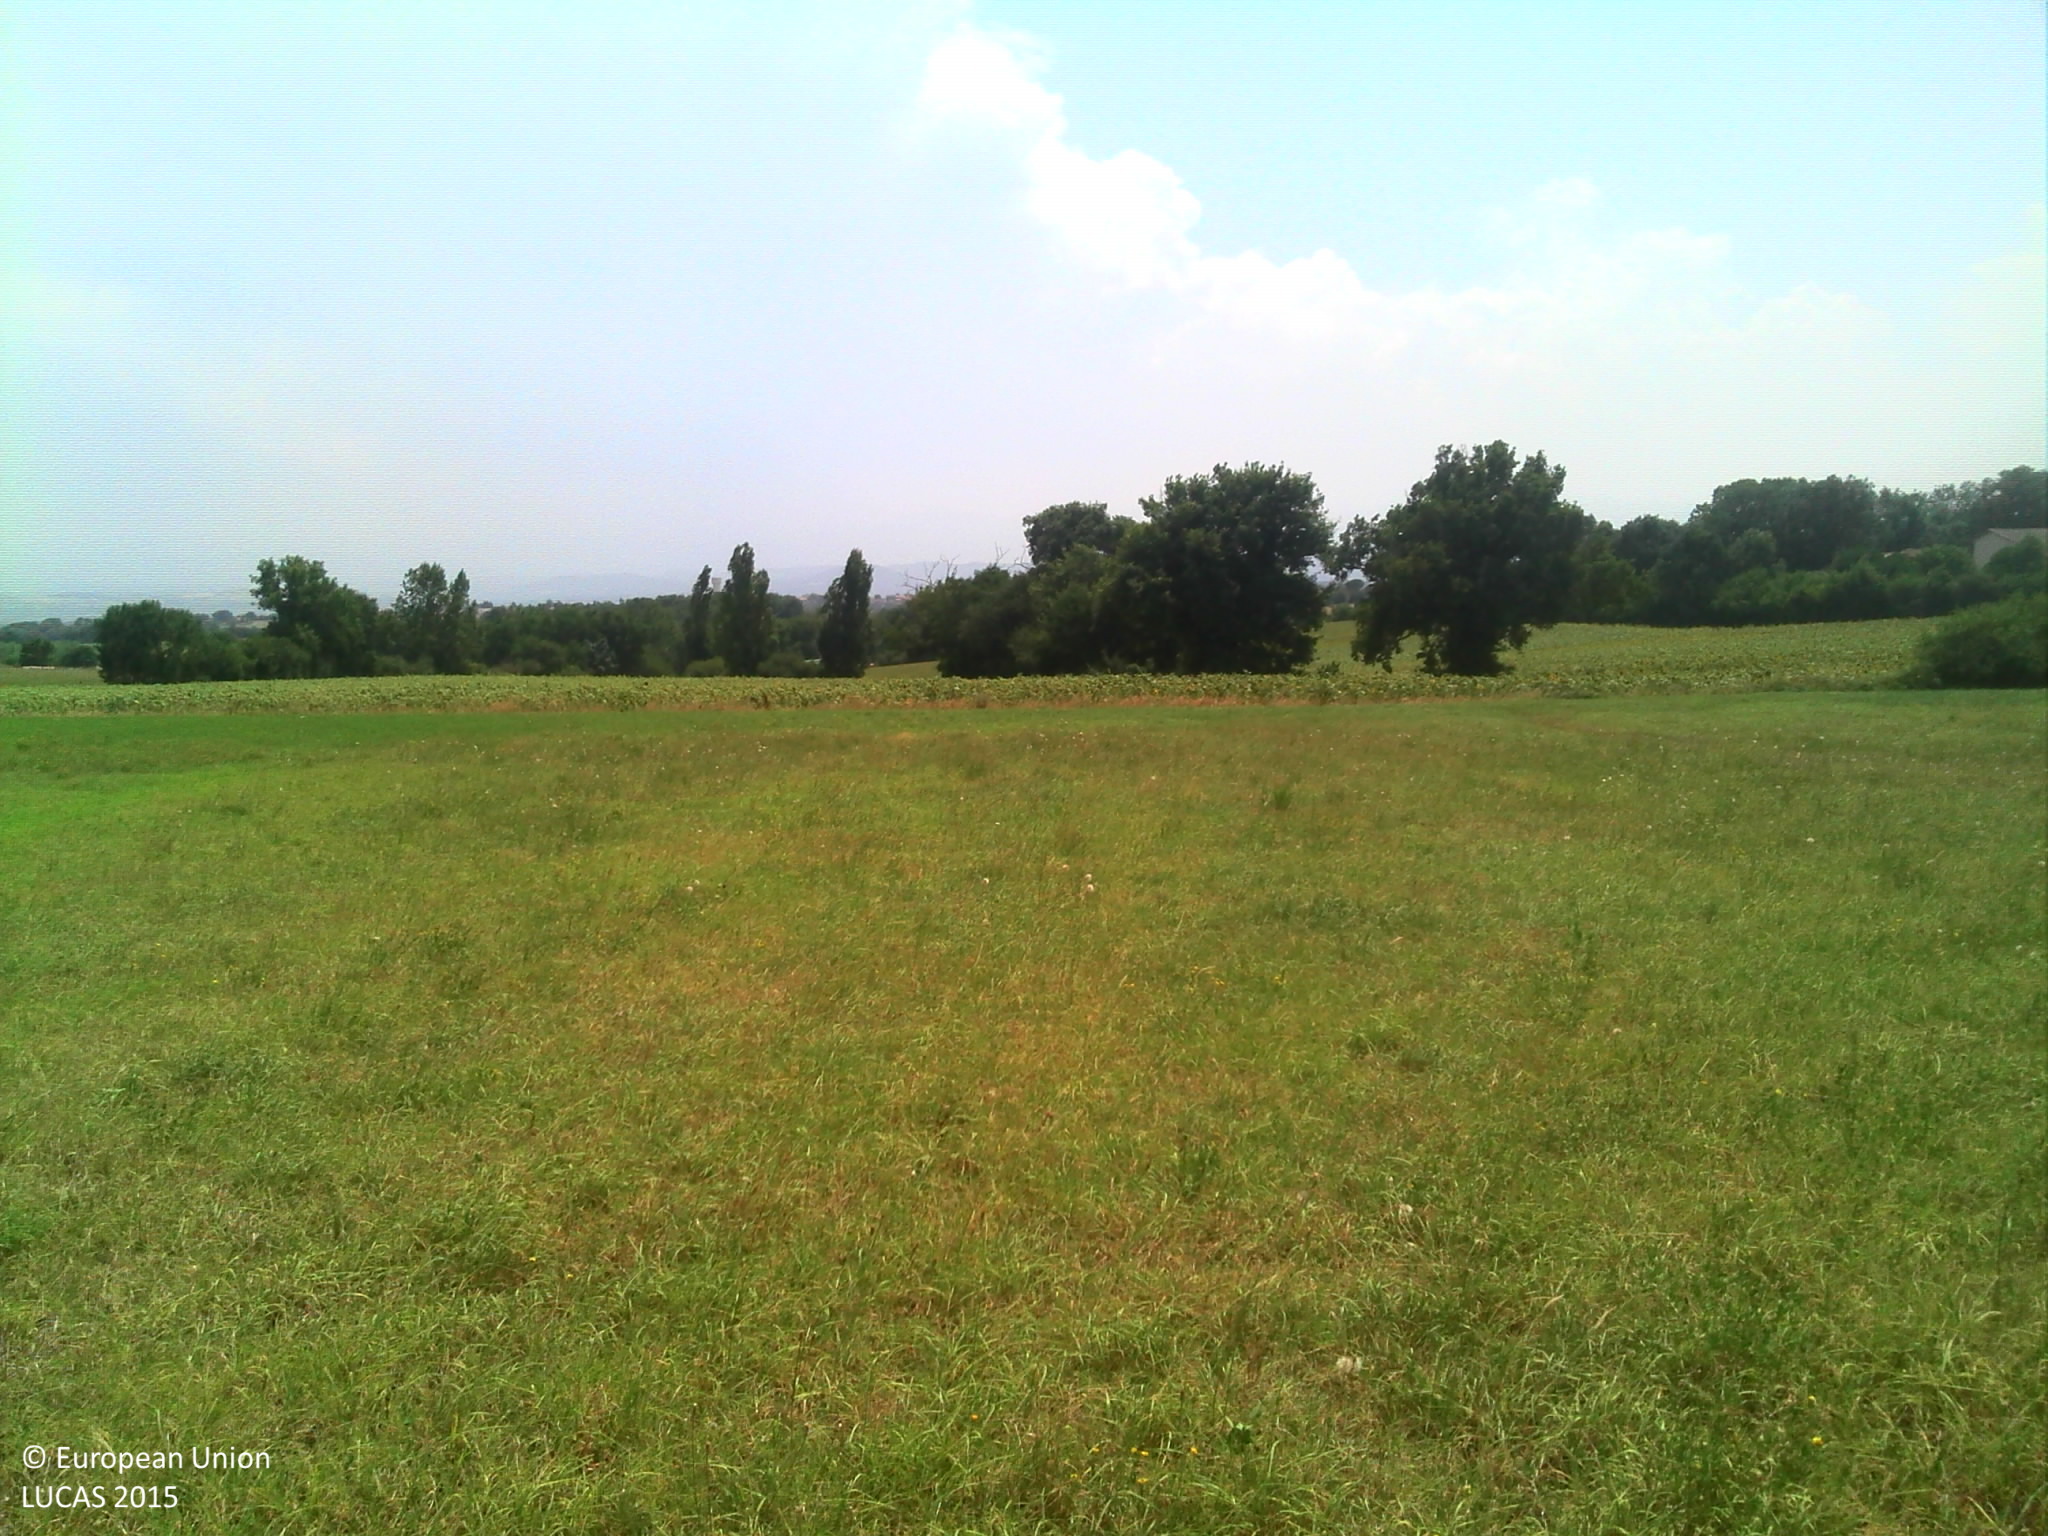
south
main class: Grassland
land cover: Grassland without tree/shrub cover
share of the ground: > 75 %
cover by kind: herbaceous plants 100 %
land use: Agriculture (excluding fallow land and kitchen gardens)
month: July
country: FR
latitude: 43.3113
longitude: 1.0638
